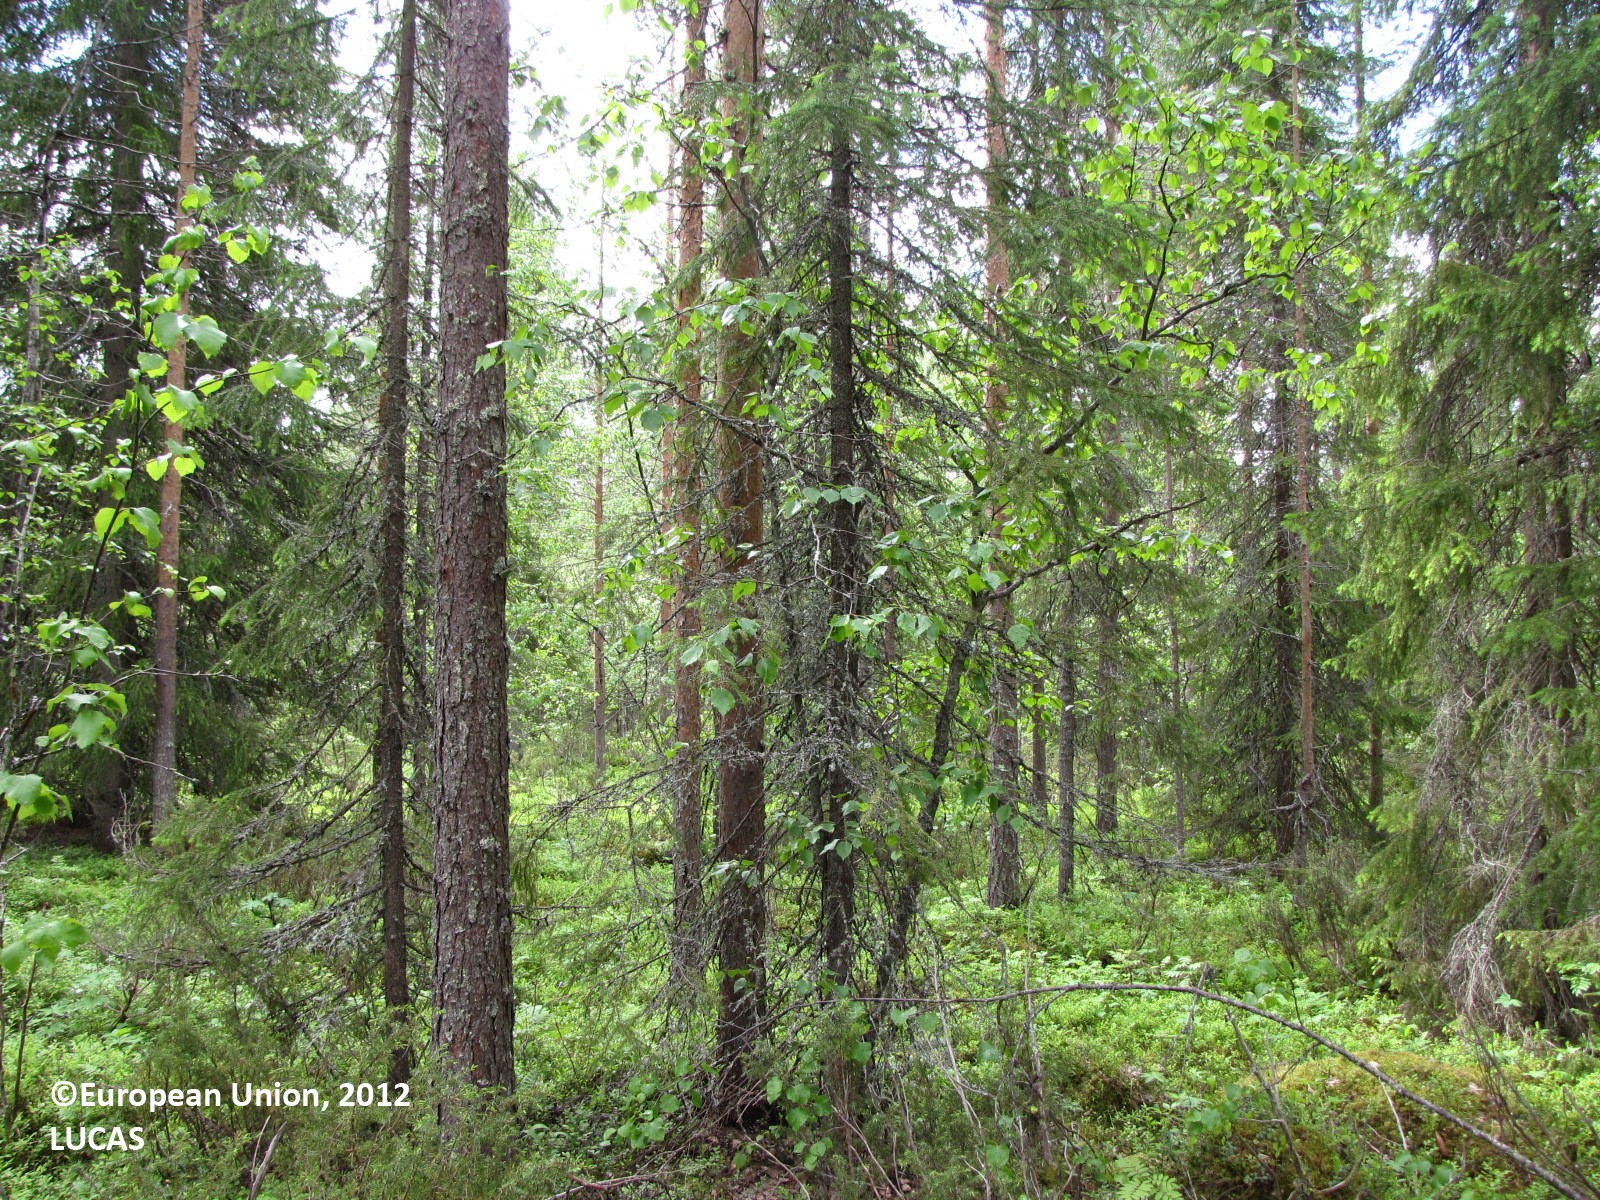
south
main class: Woodland
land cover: Pine dominated mixed woodland
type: boreal forest
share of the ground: 10 - 25 %
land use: Forestry
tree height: > 5 m
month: June
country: FI
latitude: 66.2318
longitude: 24.9768
